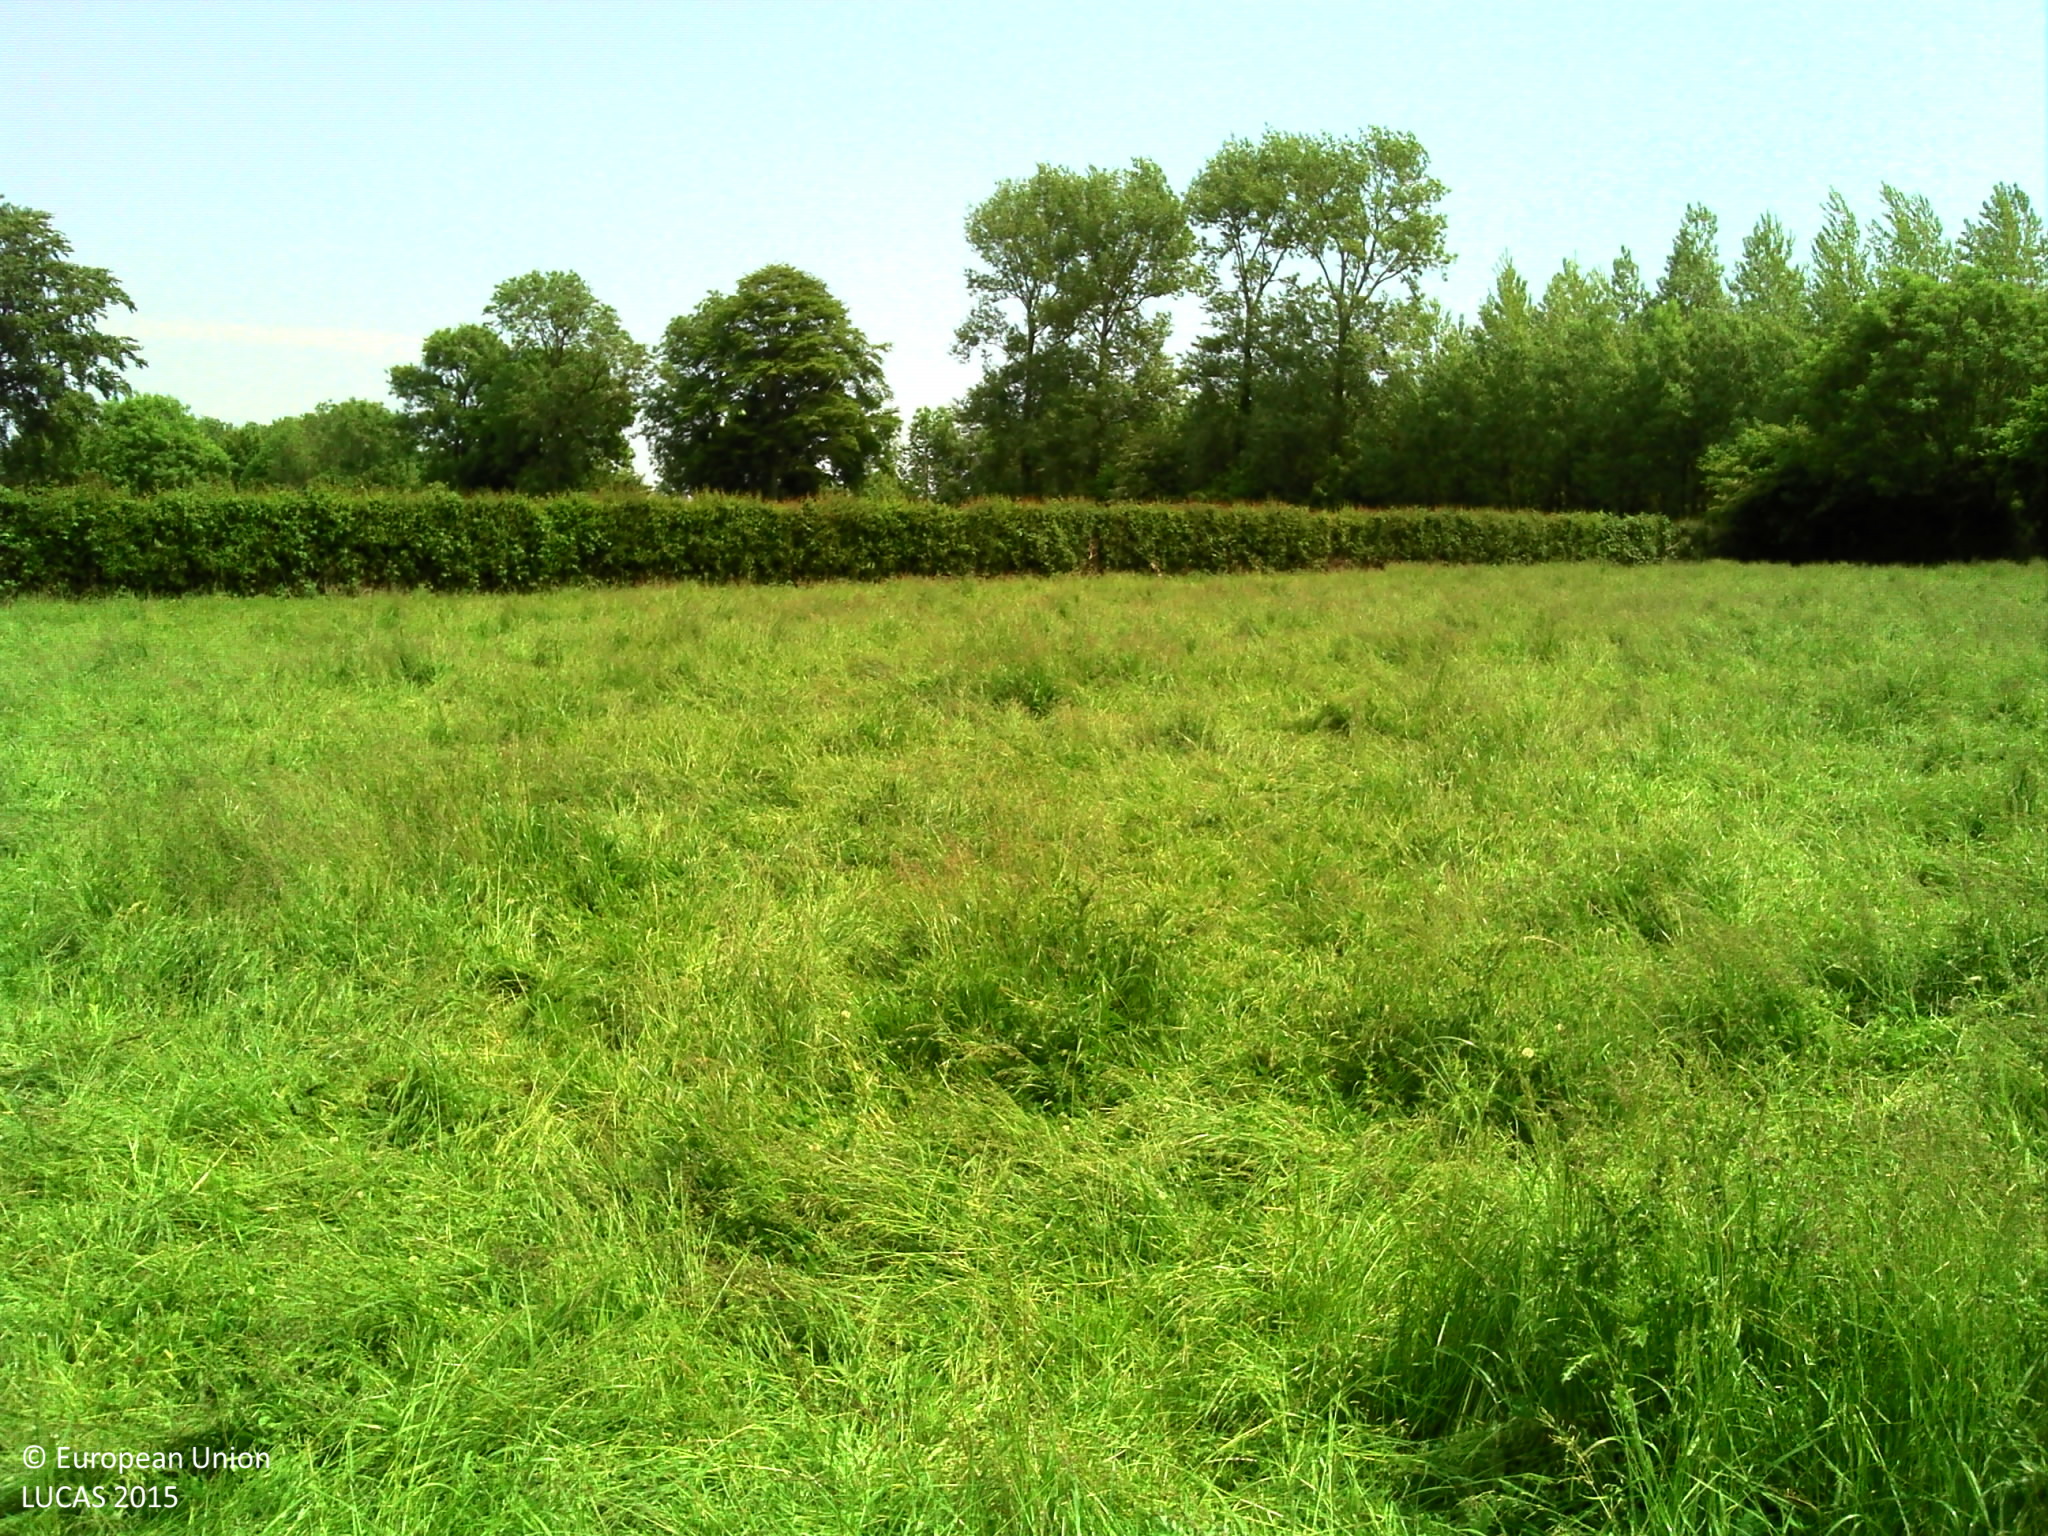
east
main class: Grassland
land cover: Grassland without tree/shrub cover
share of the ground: > 75 %
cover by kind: herbaceous plants 100 %
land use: Agriculture (excluding fallow land and kitchen gardens)
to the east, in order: Grassland without tree/shrub cover; Managed hedges; Grassland without tree/shrub cover; Managed hedges; Grass margins; Tracks; Grass margins; Fences; Broadleaved woodland; Tracks; Managed hedges; Grassland without tree/shrub cover; Managed hedges; Grassland without tree/shrub cover; Managed hedges; Grassland without tree/shrub cover
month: June
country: FR
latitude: 50.6313
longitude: 2.0818
